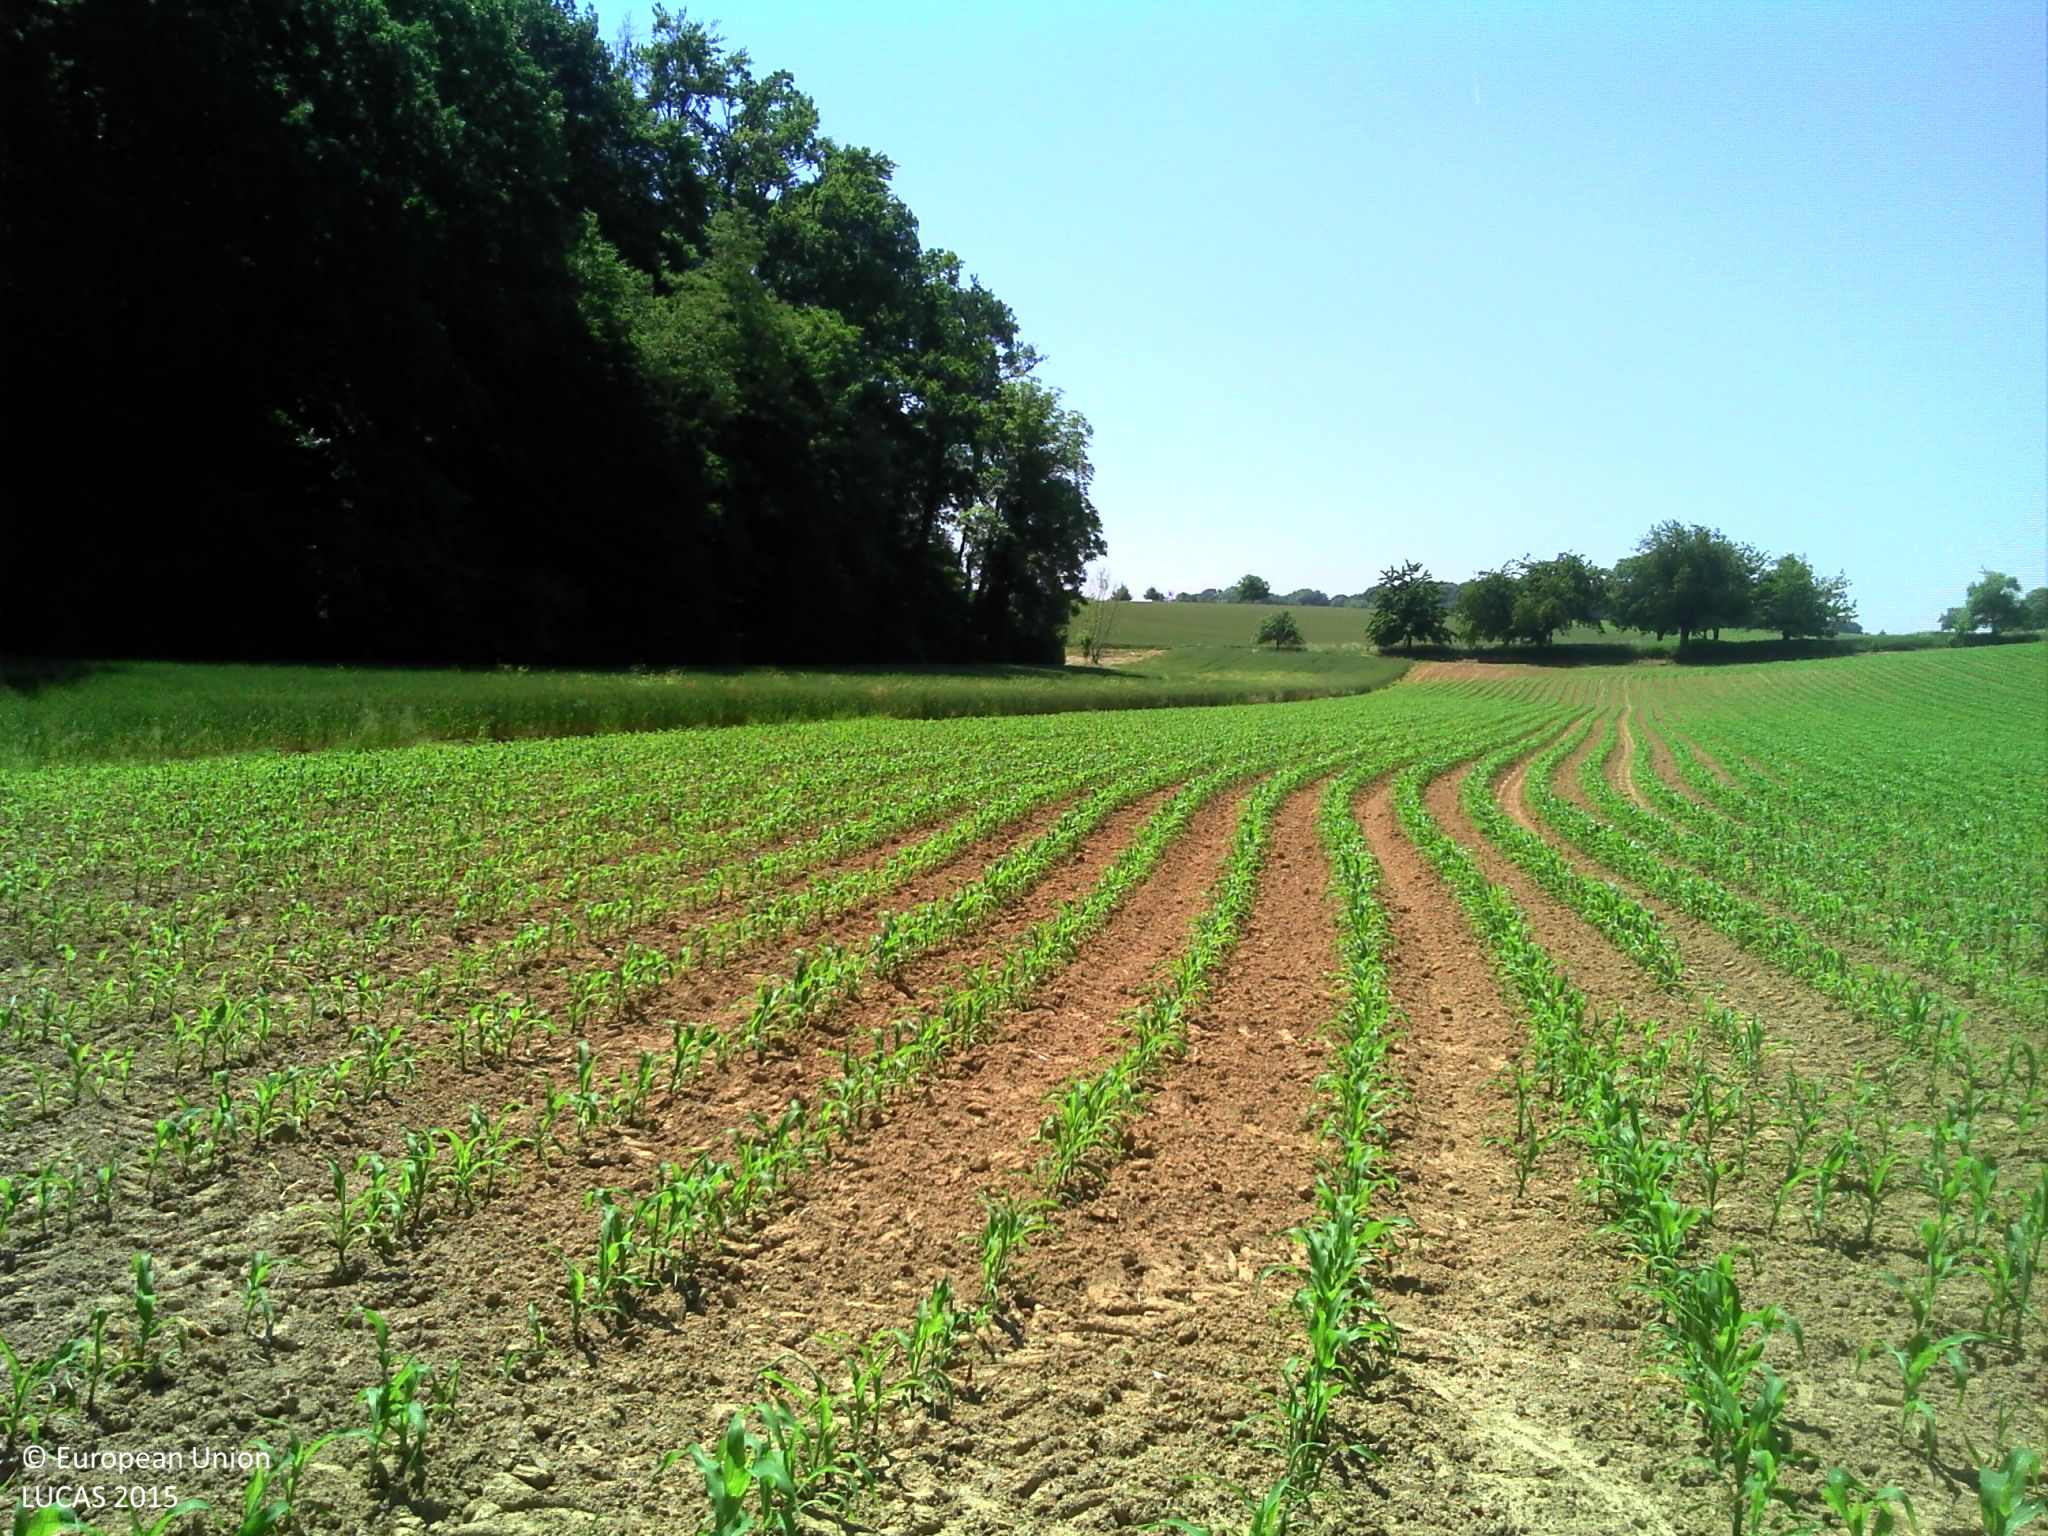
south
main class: Cropland
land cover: Maize
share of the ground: 10 - 25 %
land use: Agriculture (excluding fallow land and kitchen gardens)
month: June
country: FR
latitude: 47.5648
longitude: 7.4895
